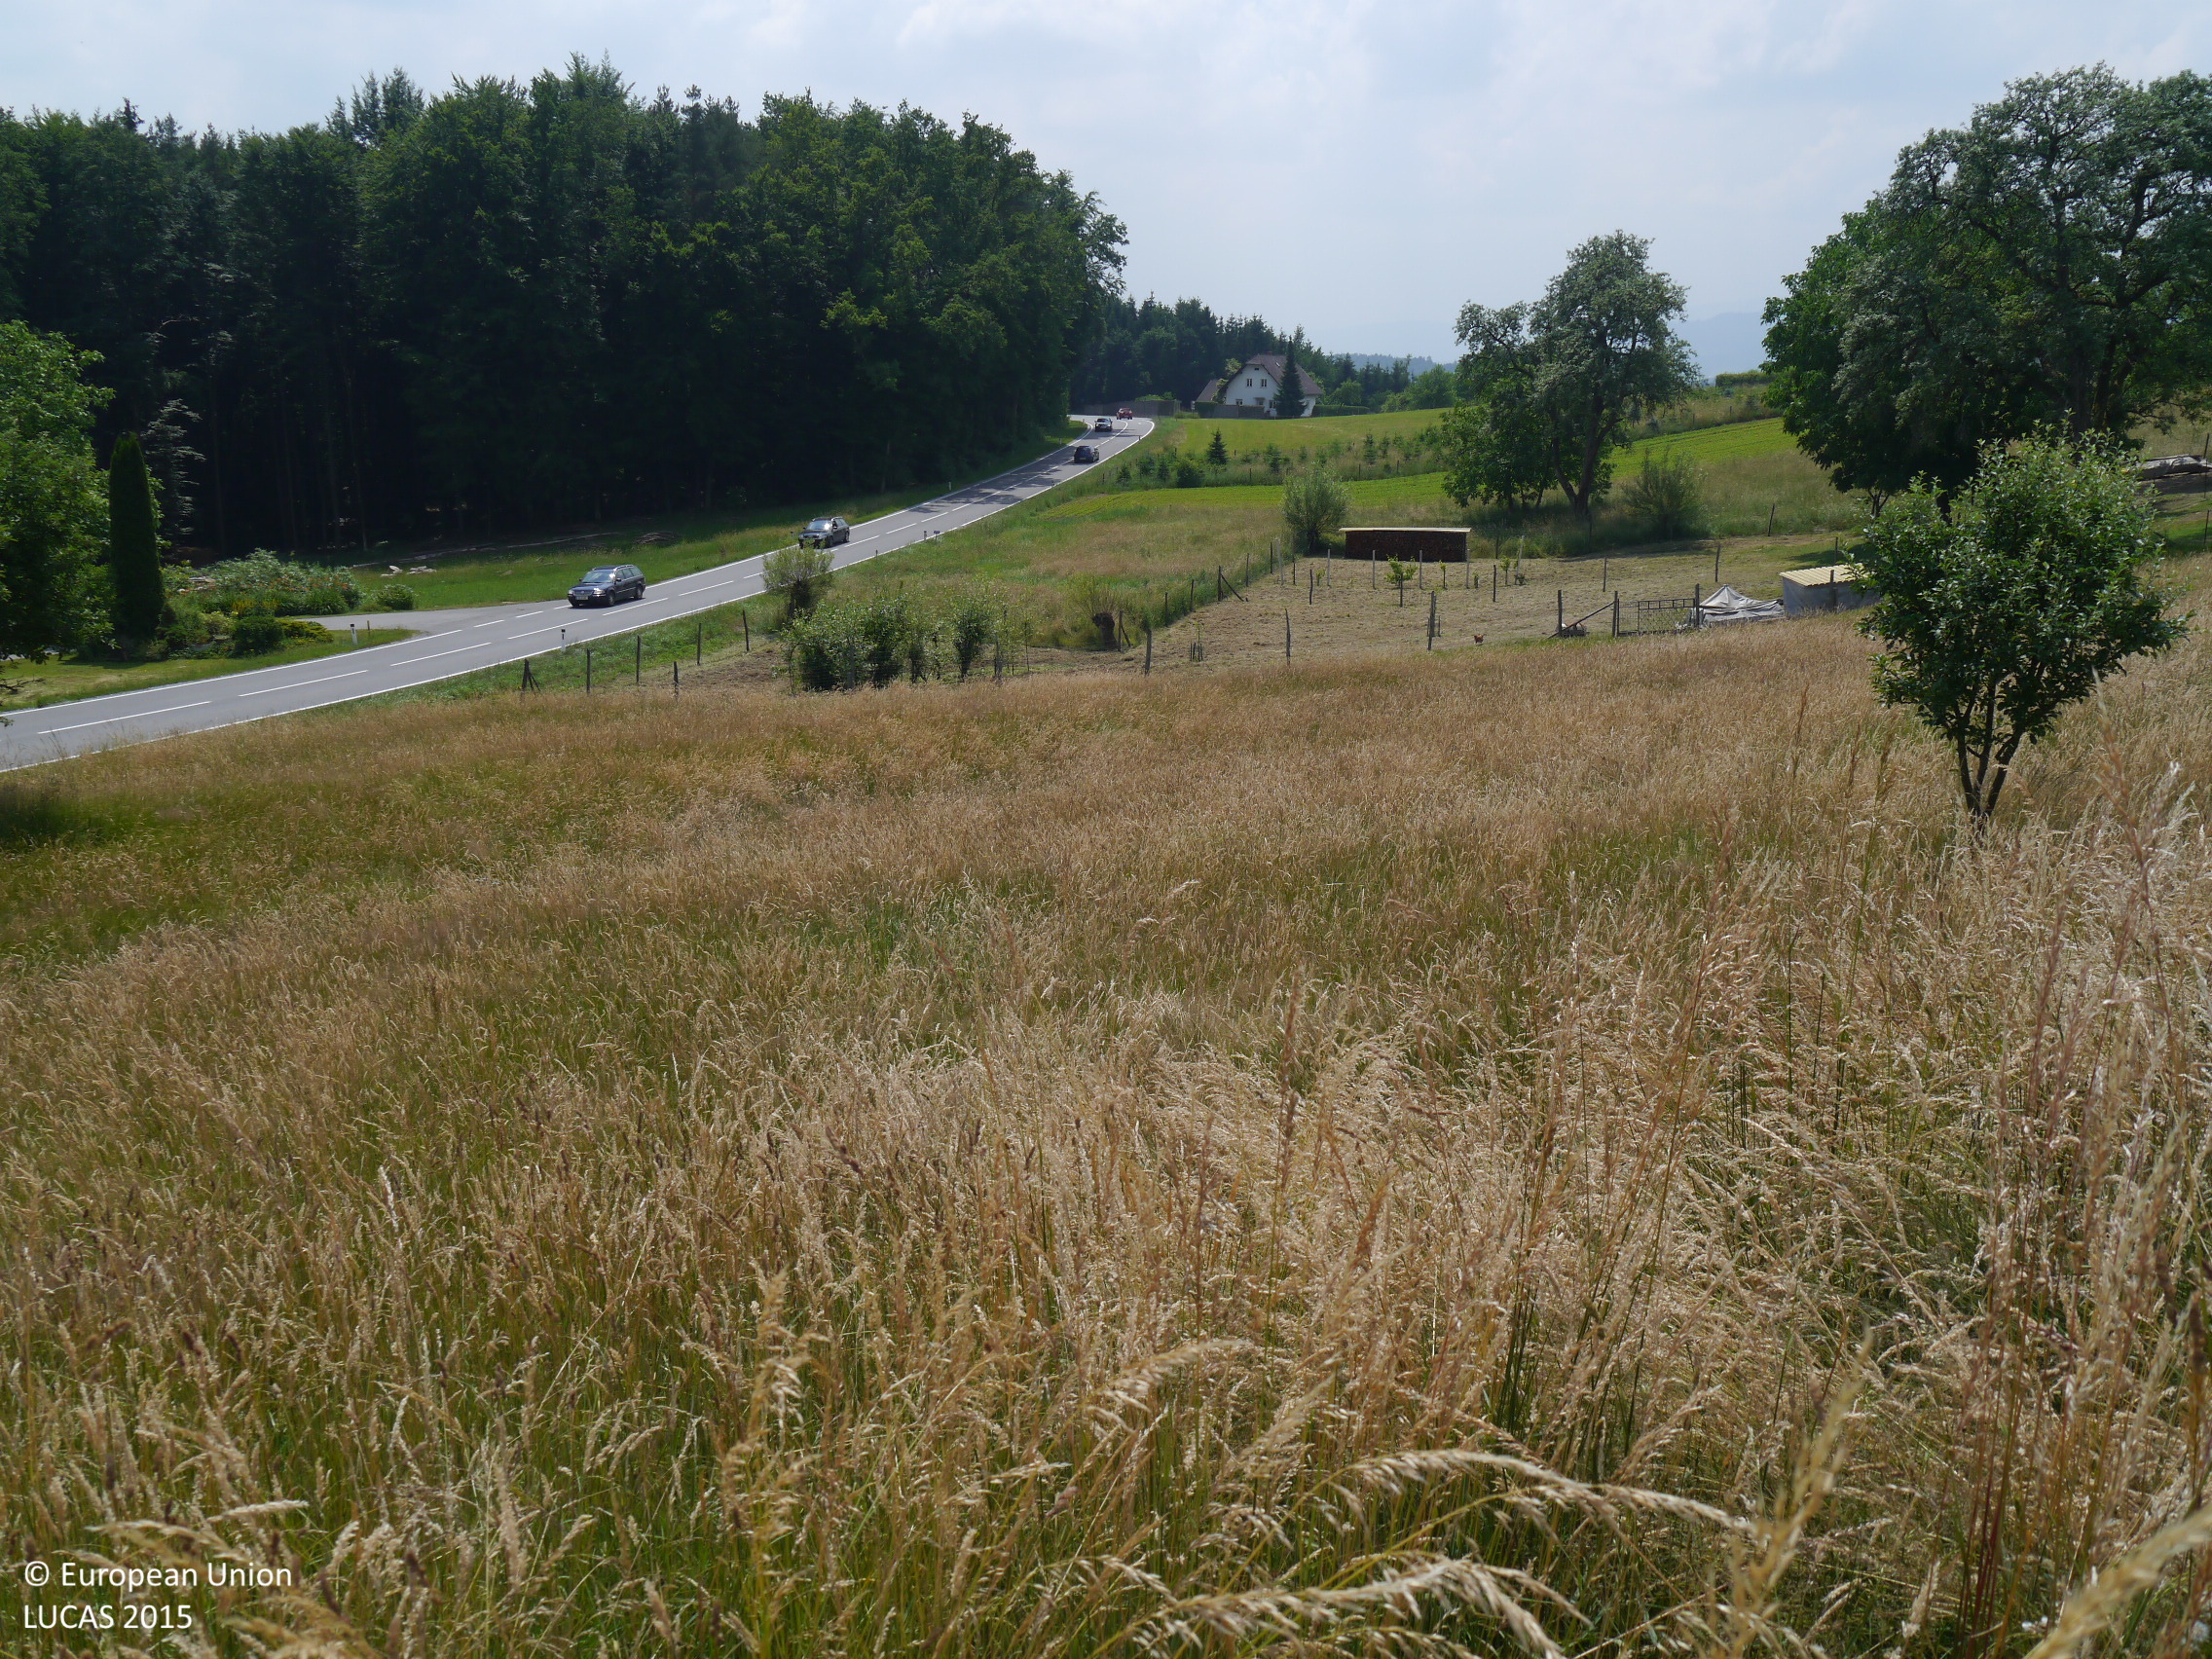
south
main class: Grassland
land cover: Grassland with sparse tree/shrub cover
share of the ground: > 75 %
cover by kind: herbaceous plants 95 %, broadleaved forest trees 5 %
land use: Agriculture (excluding fallow land and kitchen gardens)
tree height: < 5 m
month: June
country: AT
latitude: 46.8715
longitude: 15.2601
